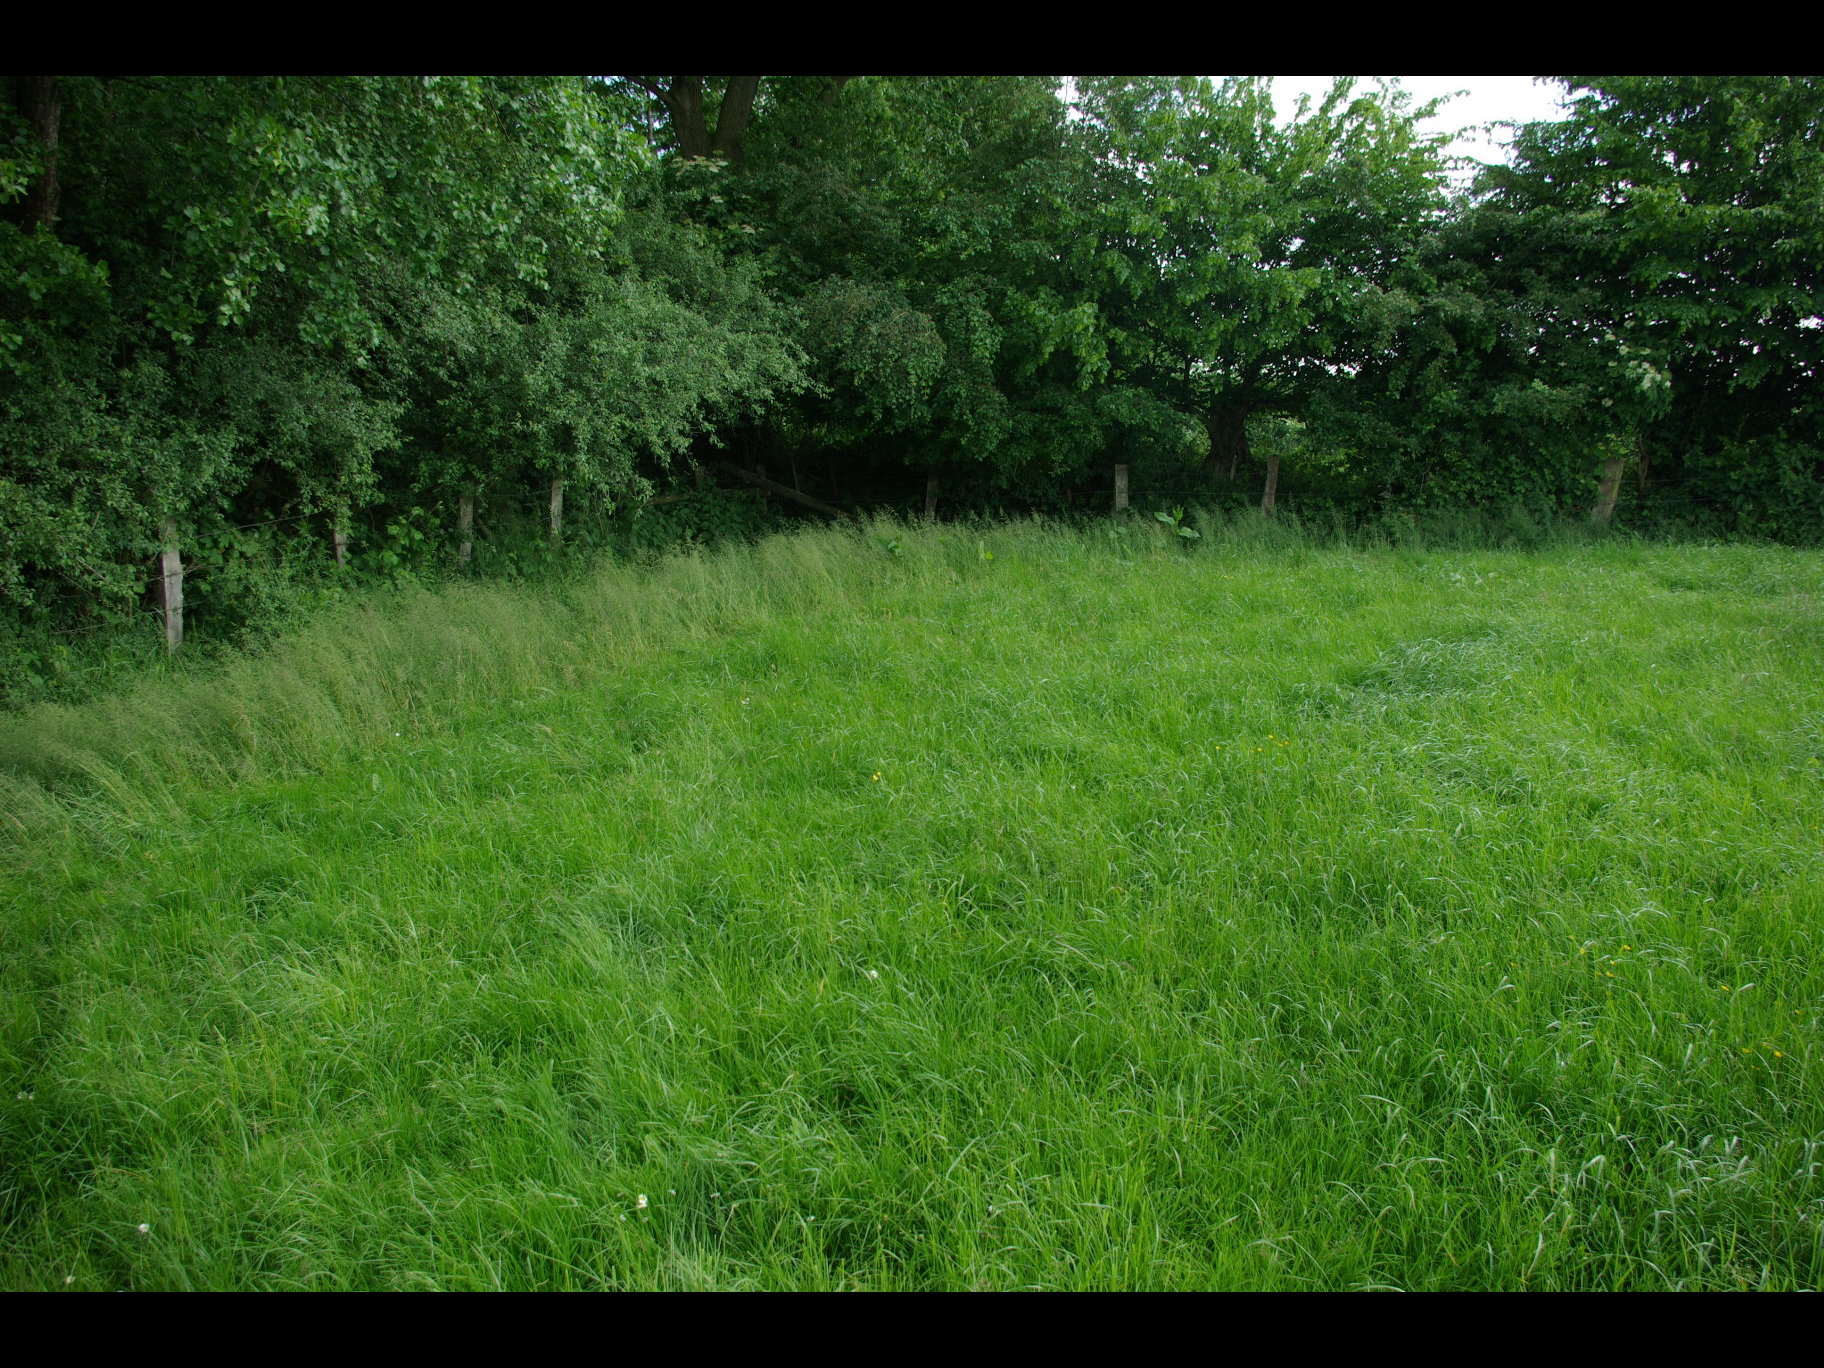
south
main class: Grassland
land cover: Grassland without tree/shrub cover
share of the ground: > 75 %
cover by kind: herbaceous plants 100 %
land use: Agriculture (excluding fallow land and kitchen gardens)
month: June
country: DE
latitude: 54.2107
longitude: 9.9540
